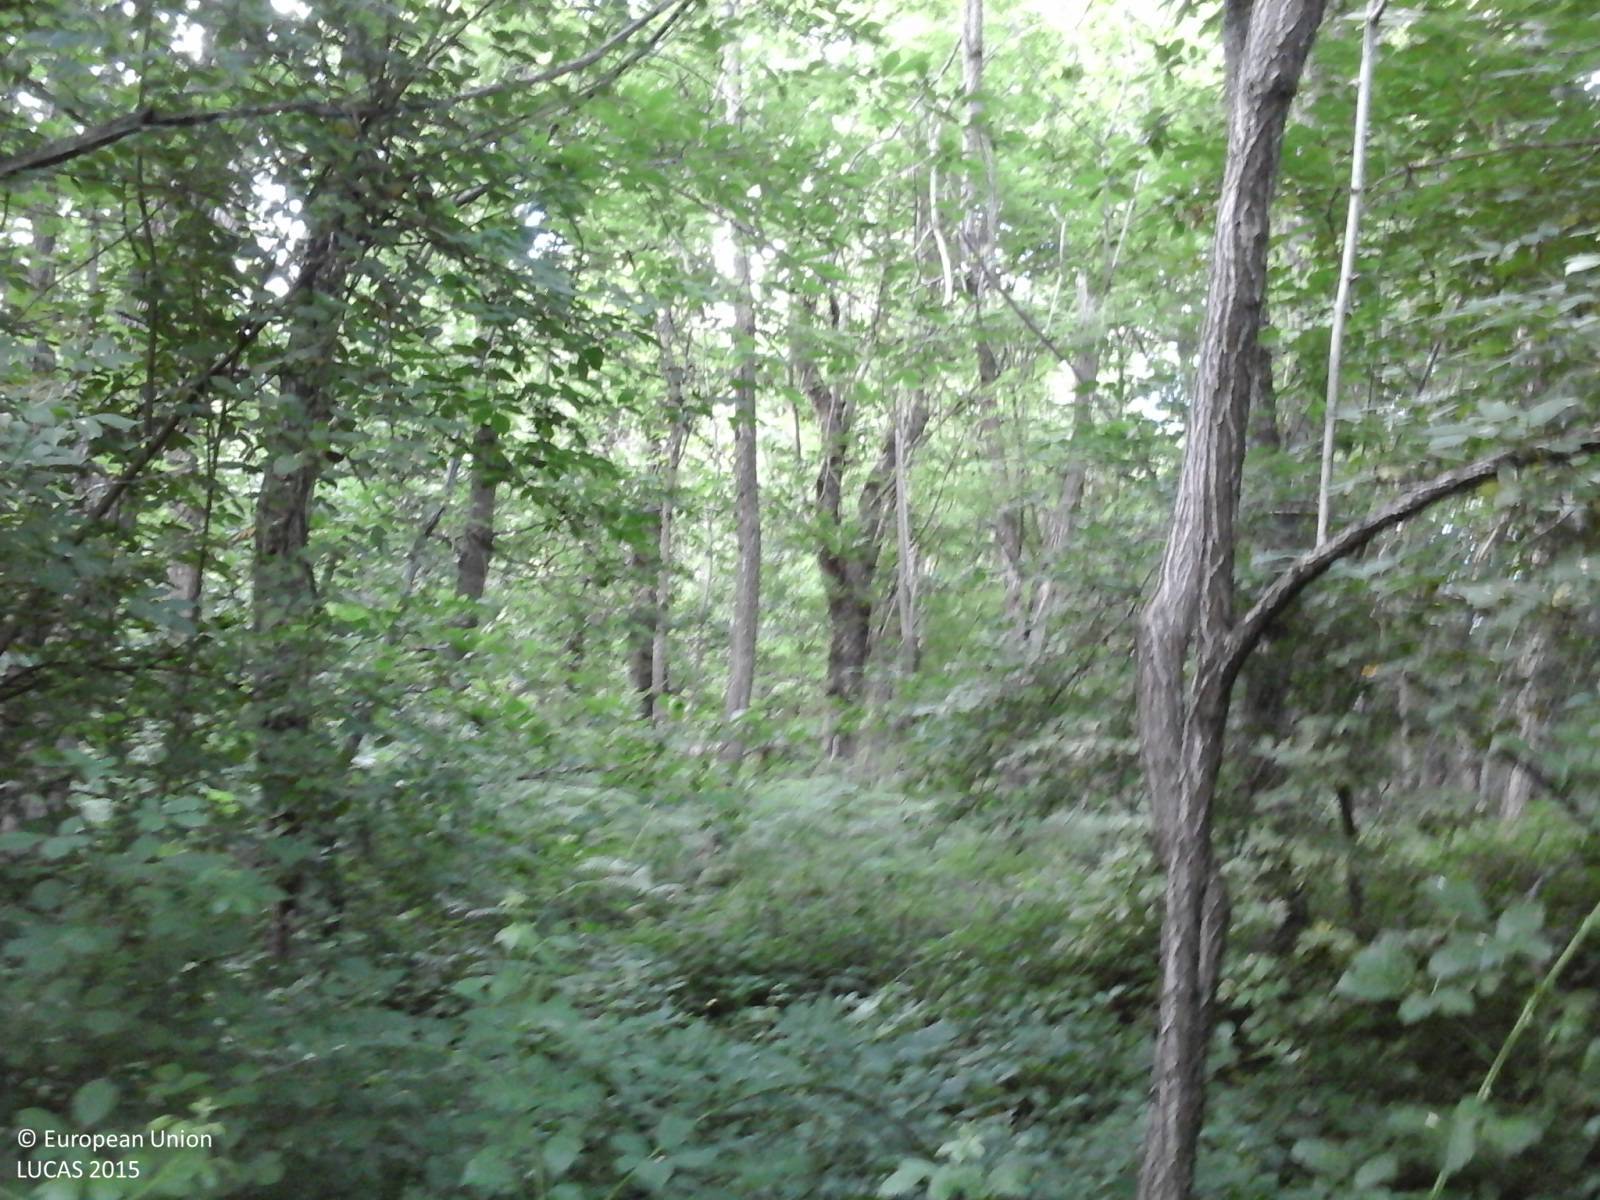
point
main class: Woodland
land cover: Broadleaved woodland
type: thermophilous deciduous forest
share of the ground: > 75 %
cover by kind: broadleaved forest trees 100 %
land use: Forestry
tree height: > 5 m
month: June
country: IT
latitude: 44.1699
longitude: 10.2370
